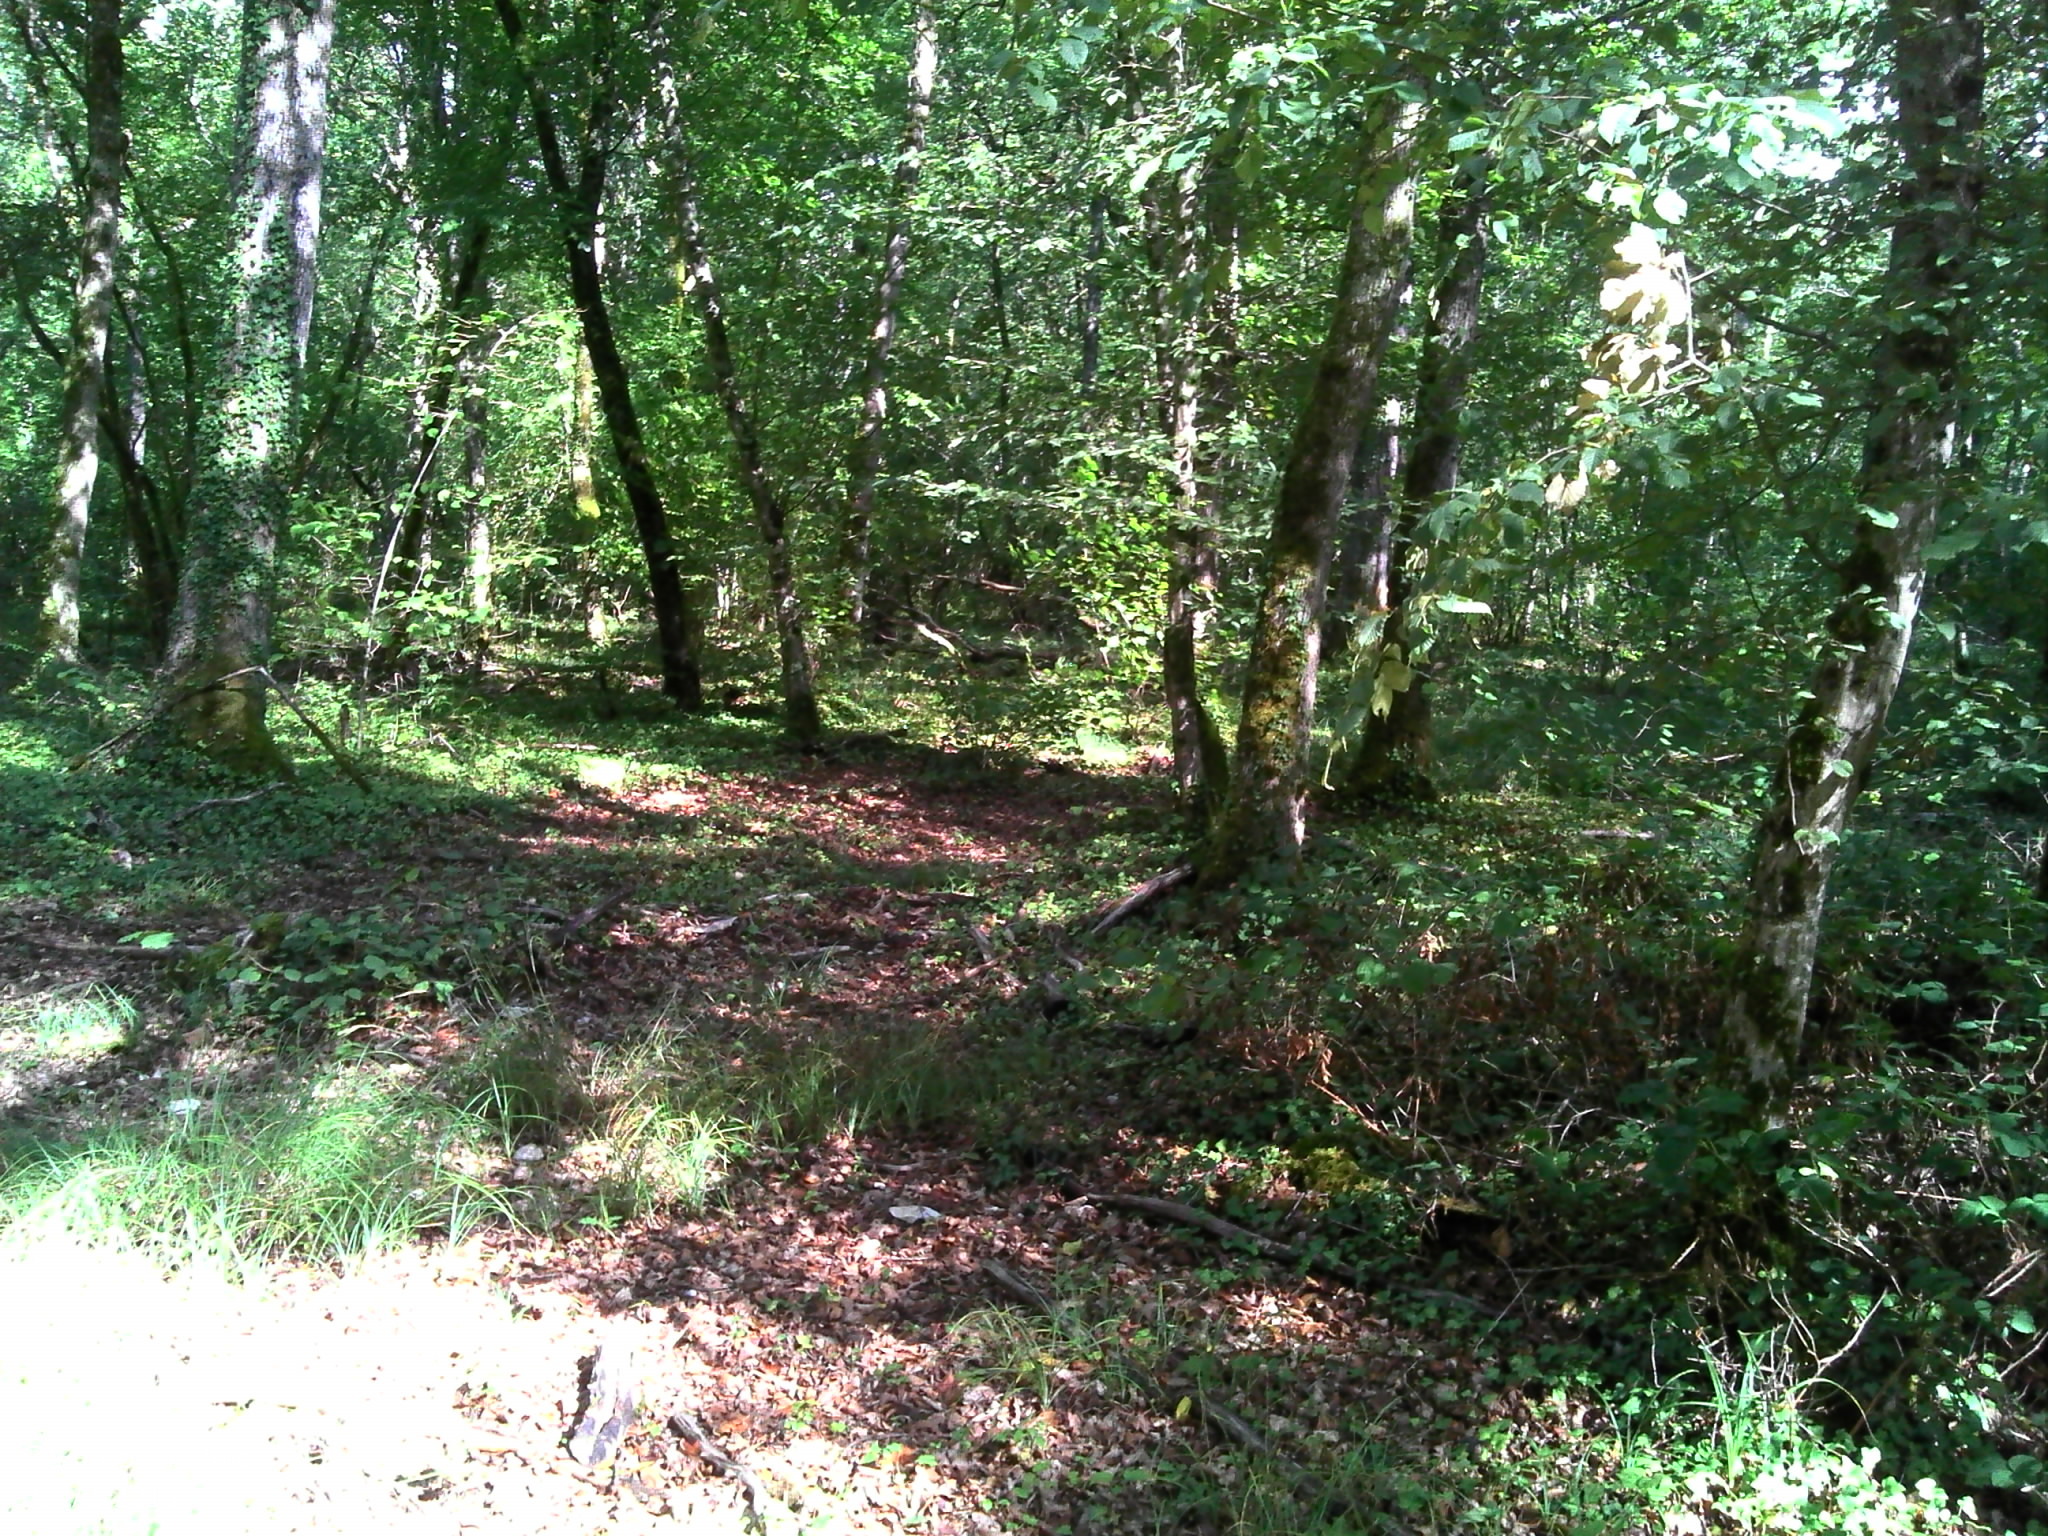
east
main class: Woodland
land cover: Broadleaved woodland
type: mesophytic deciduous forest
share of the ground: > 75 %
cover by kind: broadleaved forest trees 85 %, shrubs 5 %, herbaceous plants 5 %, lichens and mosses 5 %
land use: Forestry
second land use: Amenities, museums, leisure
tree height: > 5 m
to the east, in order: Broadleaved woodland; Tracks; Broadleaved woodland
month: August
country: FR
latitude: 47.8559
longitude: 4.9605
